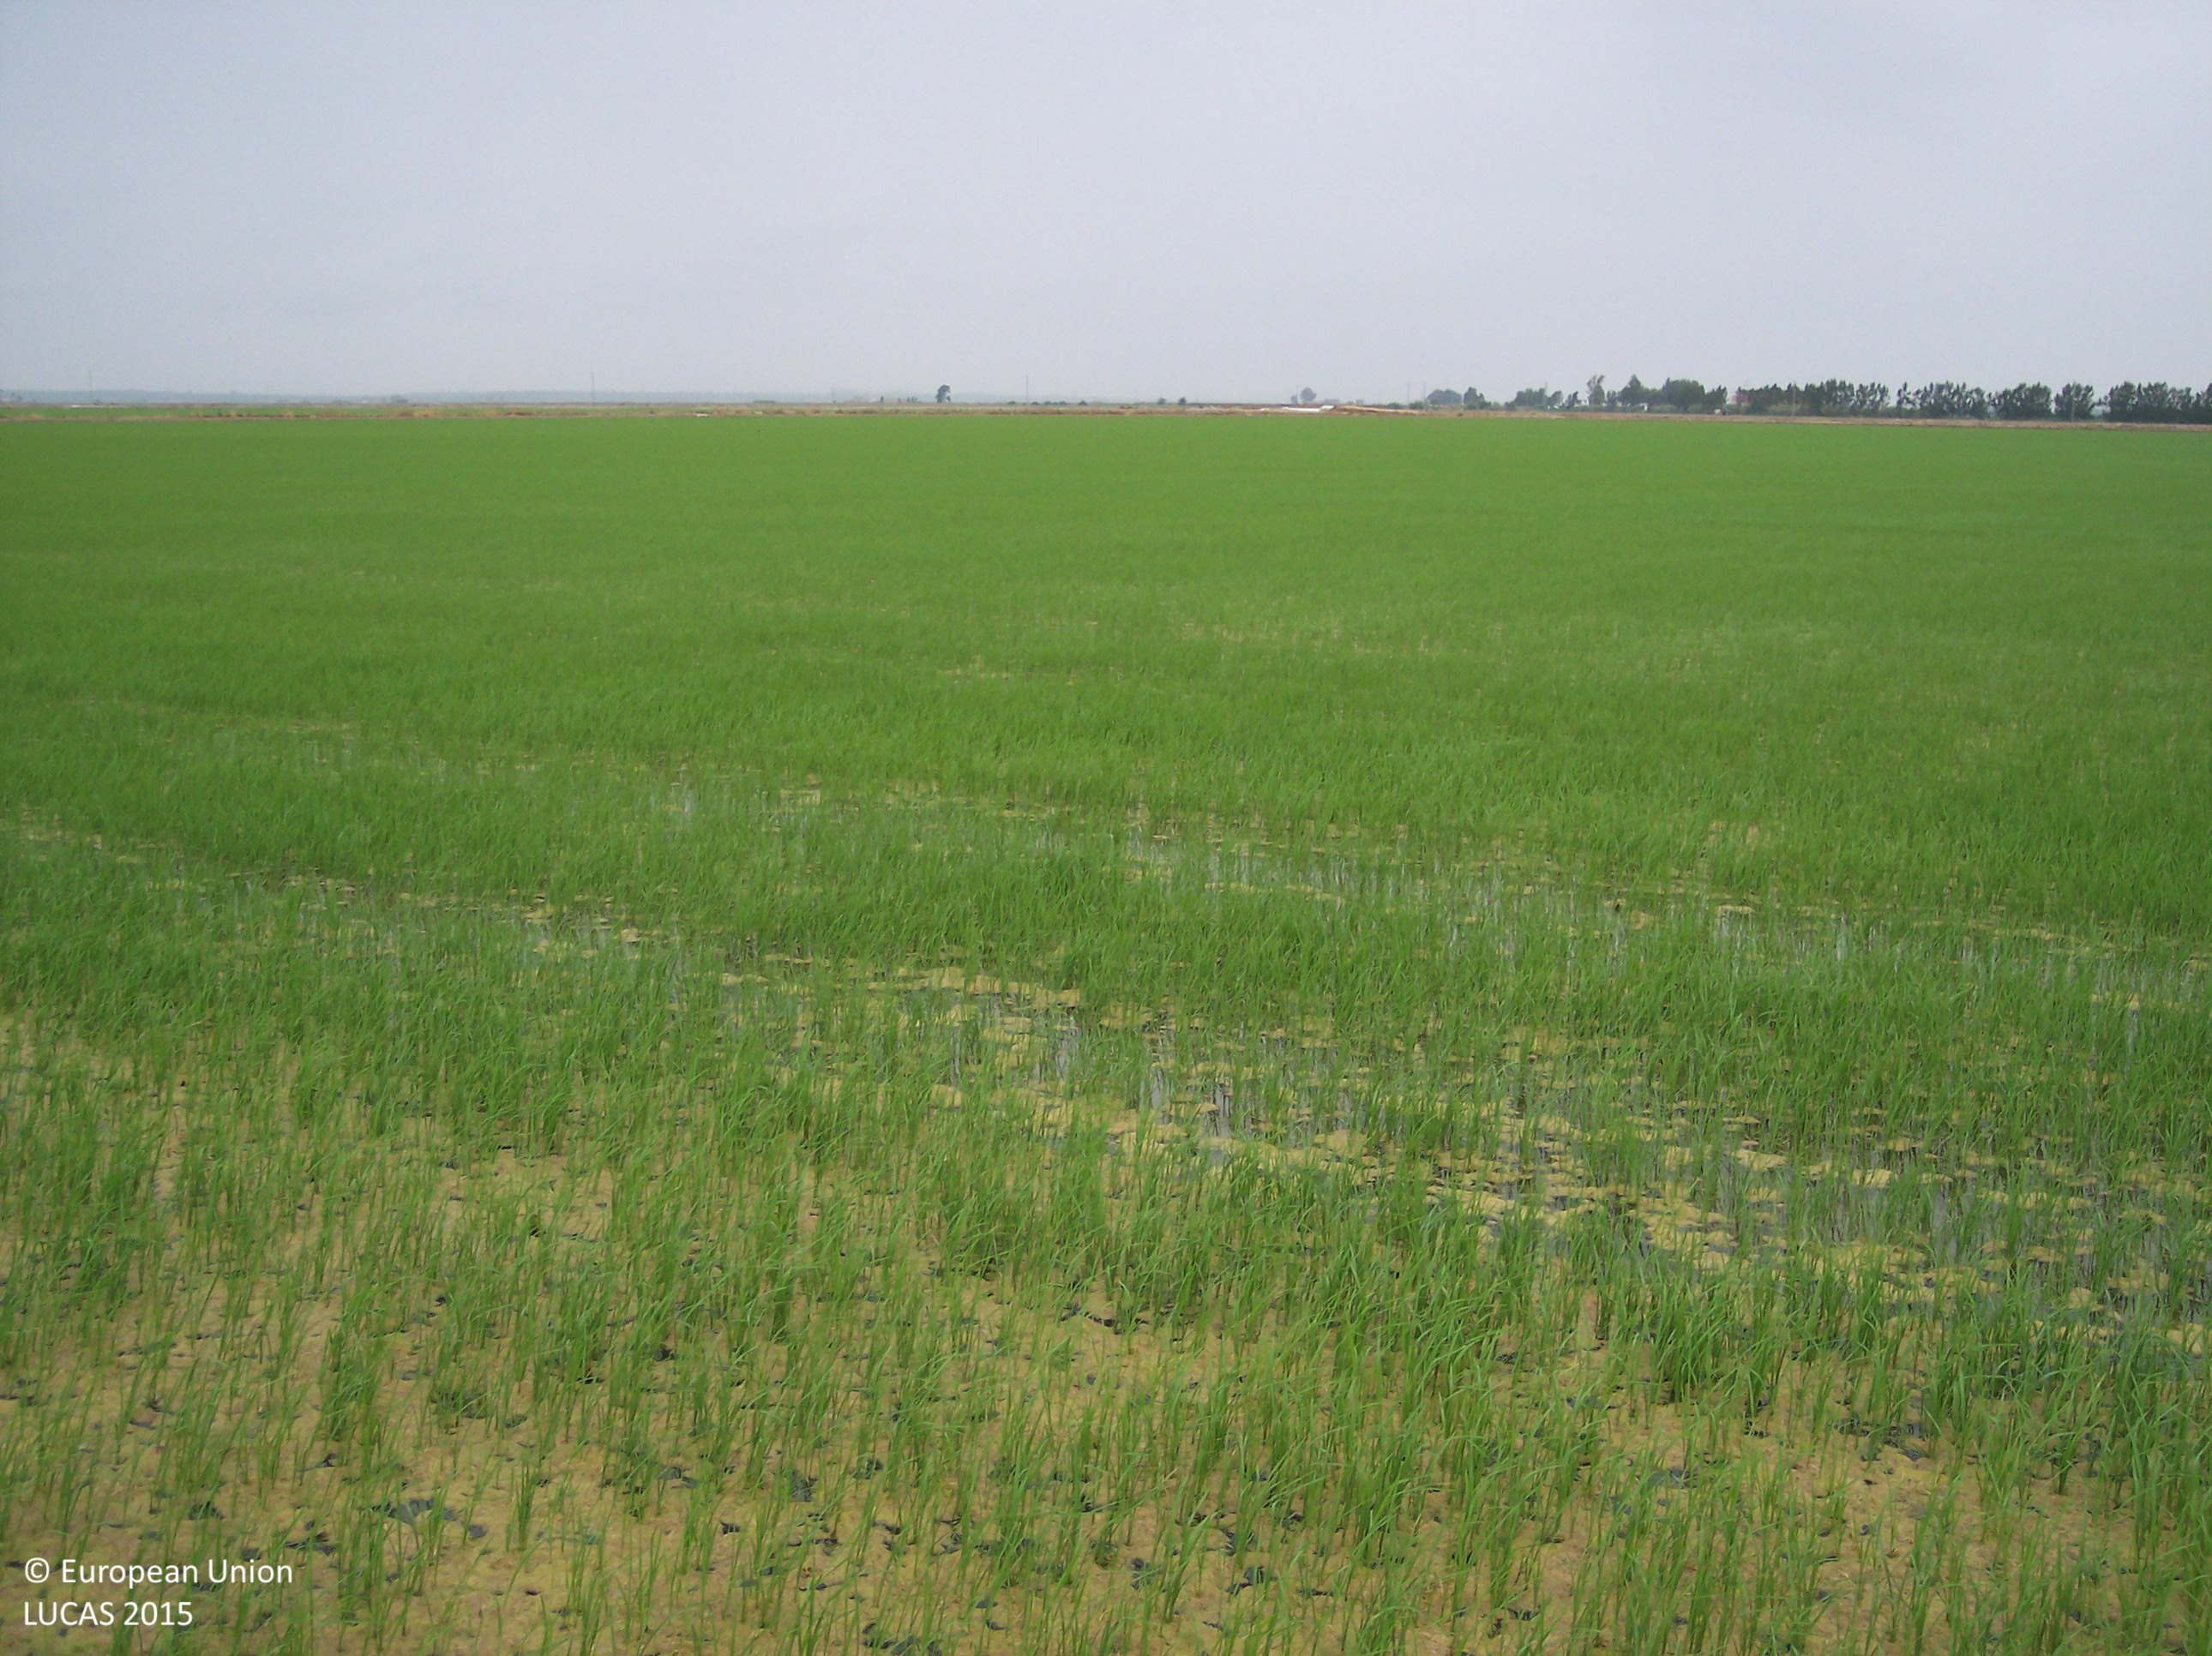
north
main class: Cropland
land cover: Rice
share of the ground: > 75 %
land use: Agriculture (excluding fallow land and kitchen gardens)
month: June
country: ES
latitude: 37.1570
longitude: -6.1120
